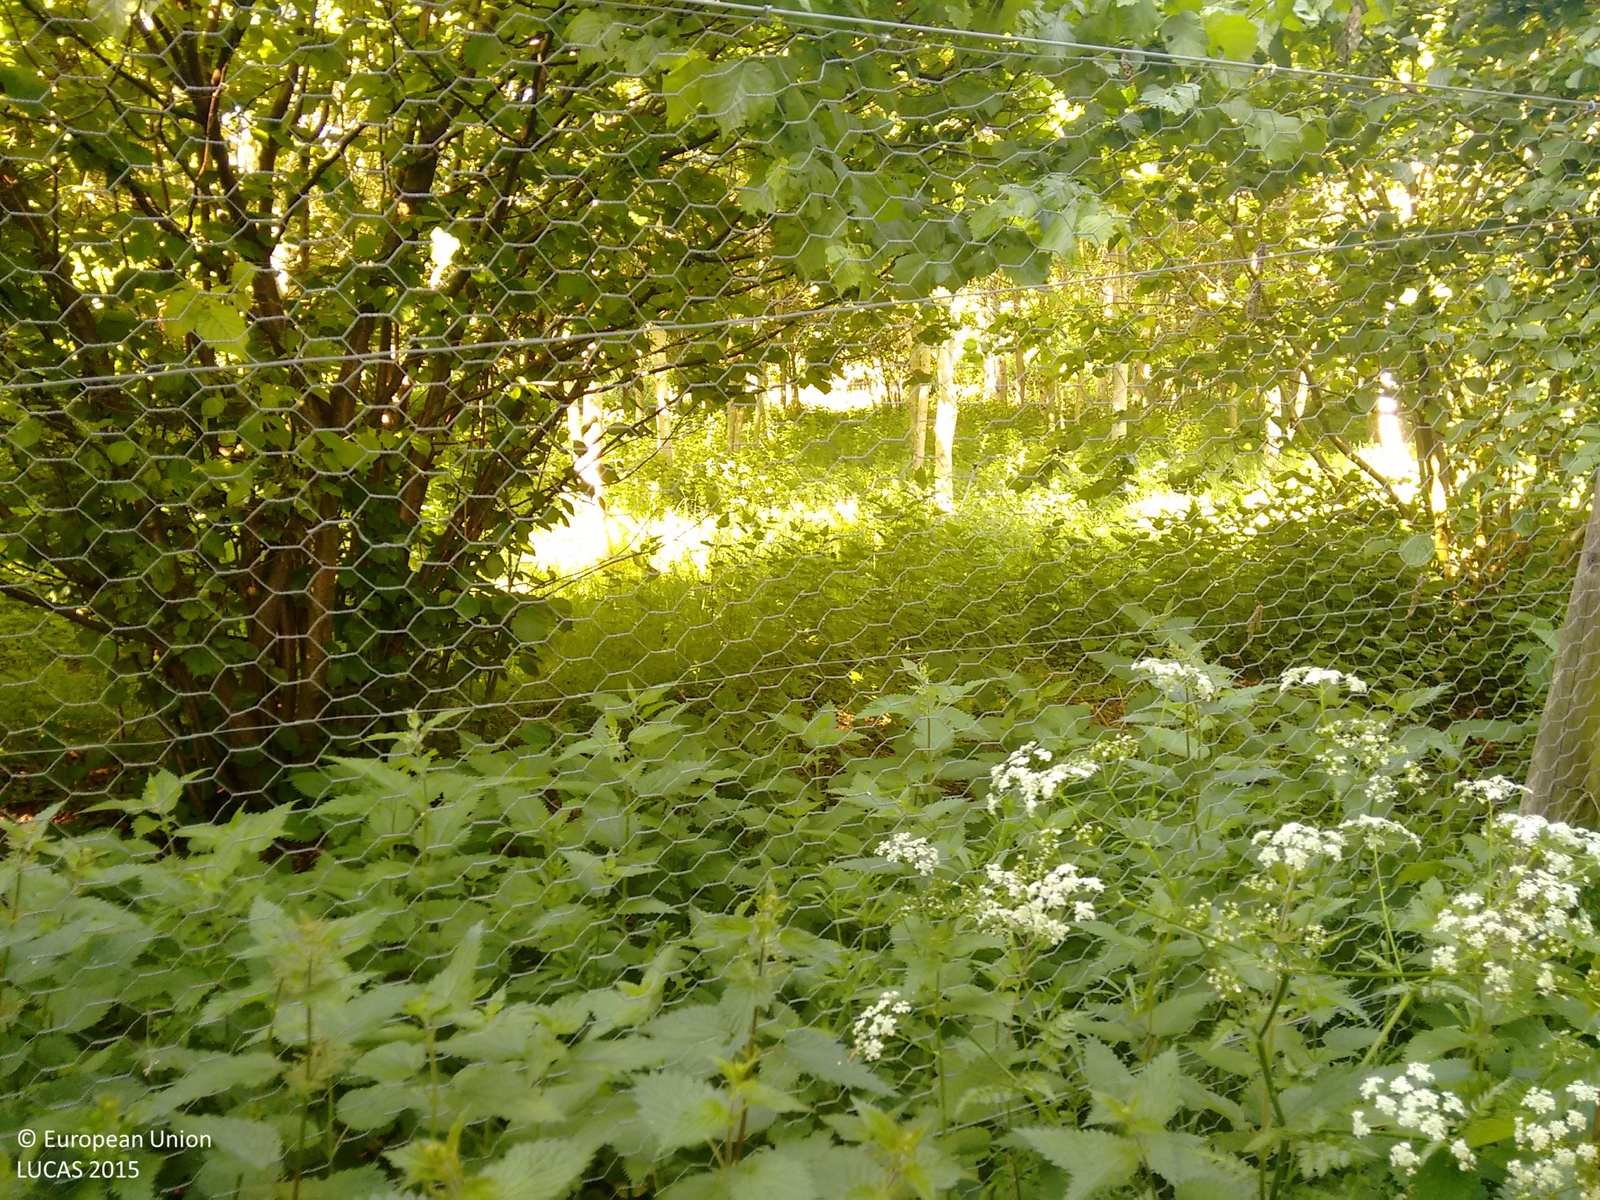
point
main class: Woodland
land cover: Broadleaved woodland
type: mesophytic deciduous forest
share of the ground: > 75 %
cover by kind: broadleaved forest trees 95 %, shrubs 5 %
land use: Forestry
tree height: > 5 m
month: June
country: GB
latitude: 51.9676
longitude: -1.6244
